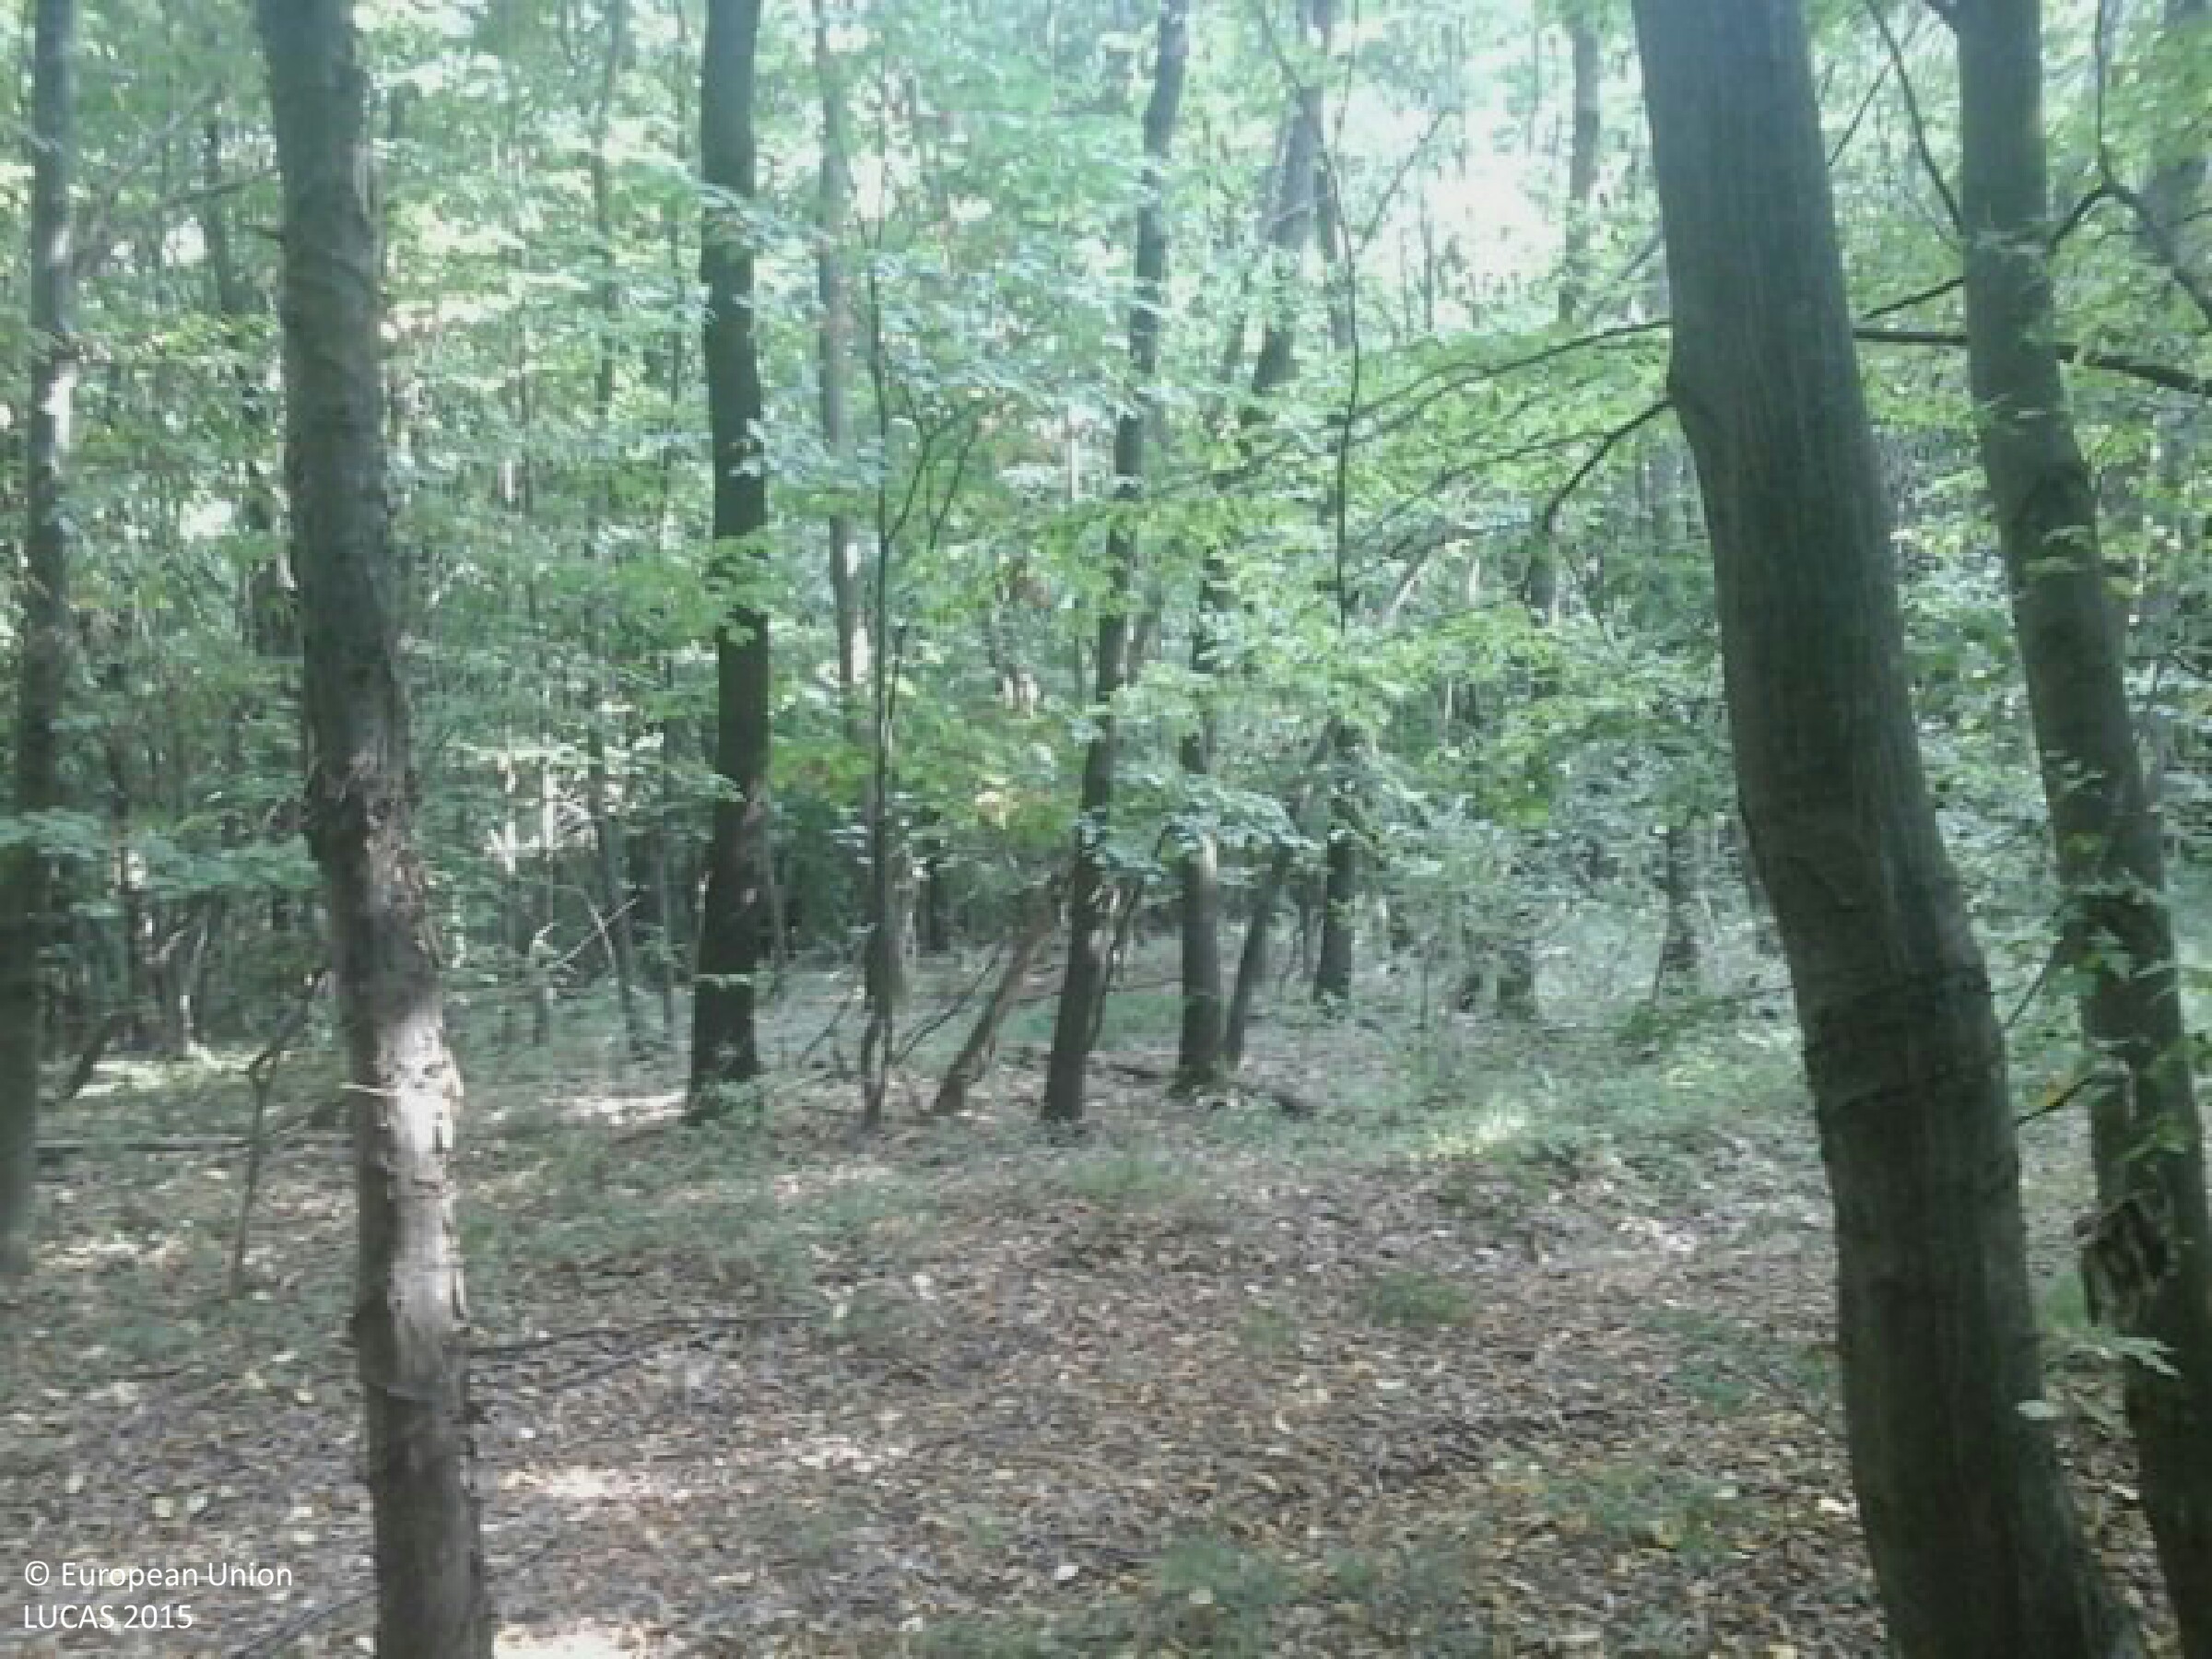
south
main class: Woodland
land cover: Broadleaved woodland
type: mesophytic deciduous forest
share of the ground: > 75 %
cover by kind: broadleaved forest trees 95 %, herbaceous plants 5 %
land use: Forestry
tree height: > 5 m
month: August
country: HU
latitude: 46.2319
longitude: 18.2416
